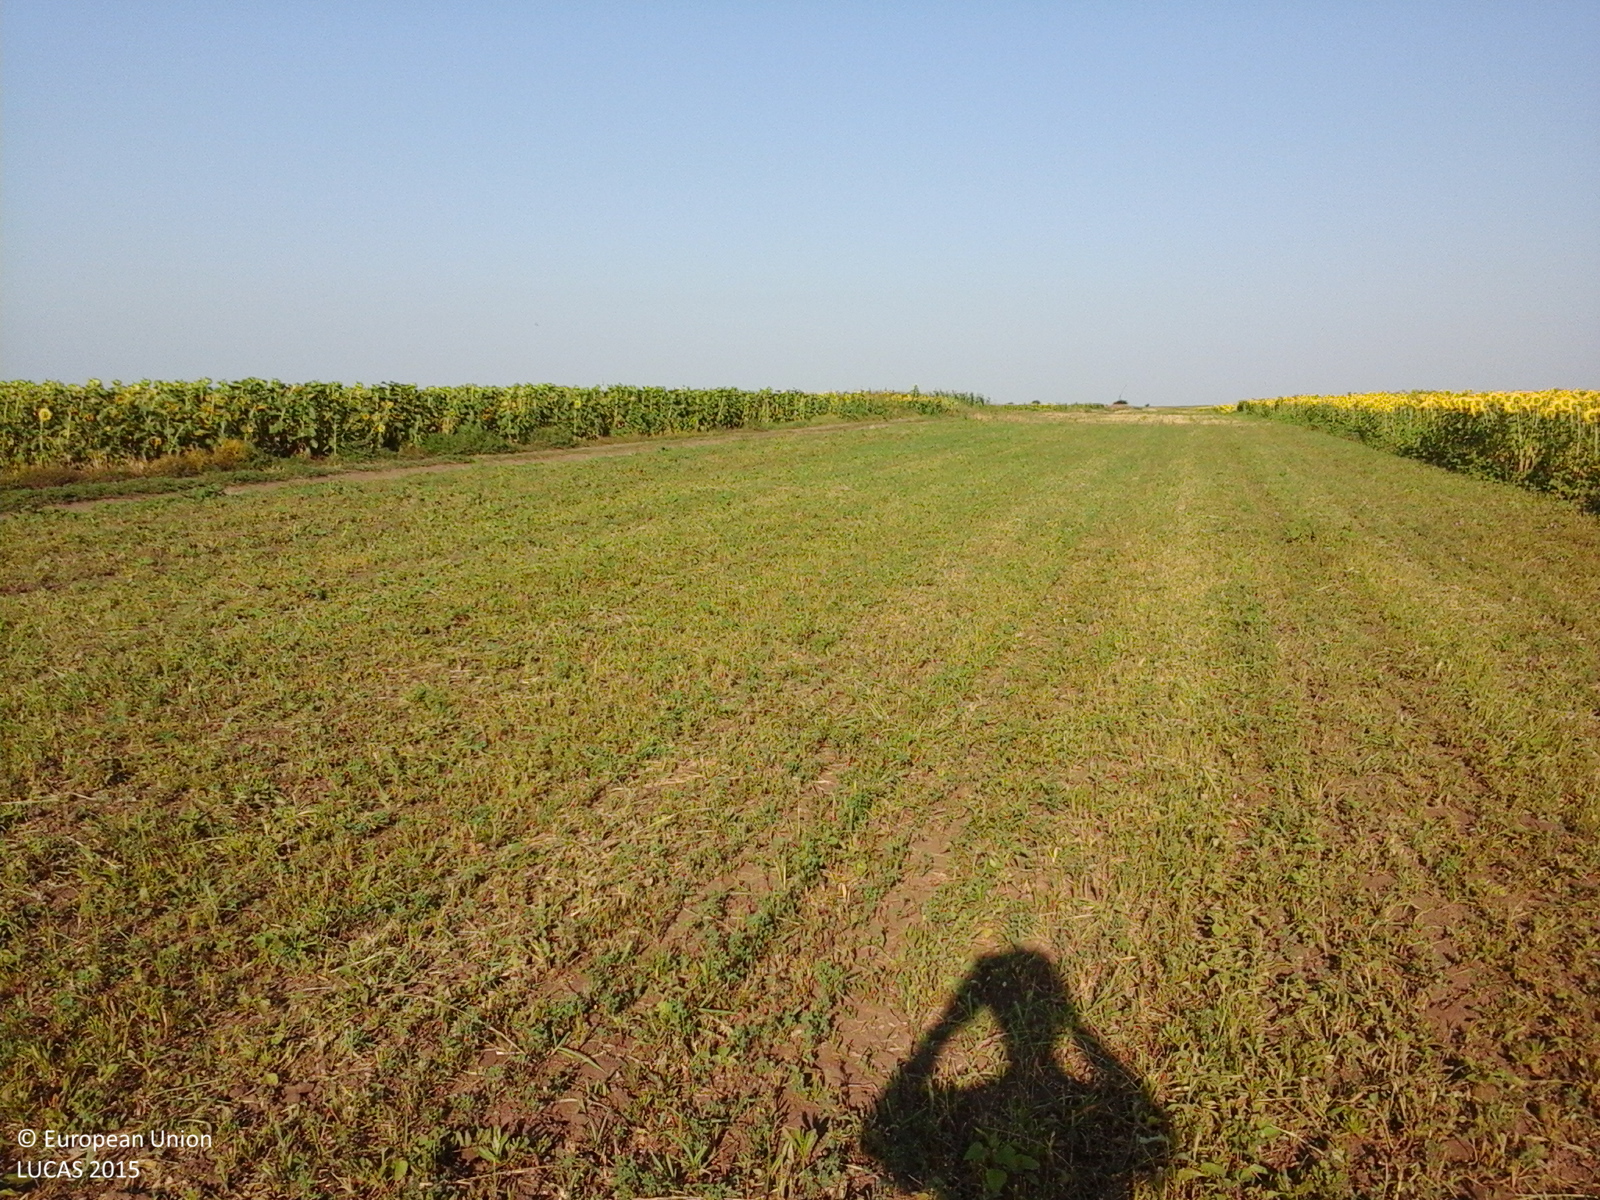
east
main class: Cropland
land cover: Lucerne
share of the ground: > 75 %
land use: Agriculture (excluding fallow land and kitchen gardens)
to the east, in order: Lucerne; Tracks; Sunflower; Maize; Common wheat; Sunflower; Lucerne; Maize; Common wheat
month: July
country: RO
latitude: 44.8120
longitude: 27.2212
